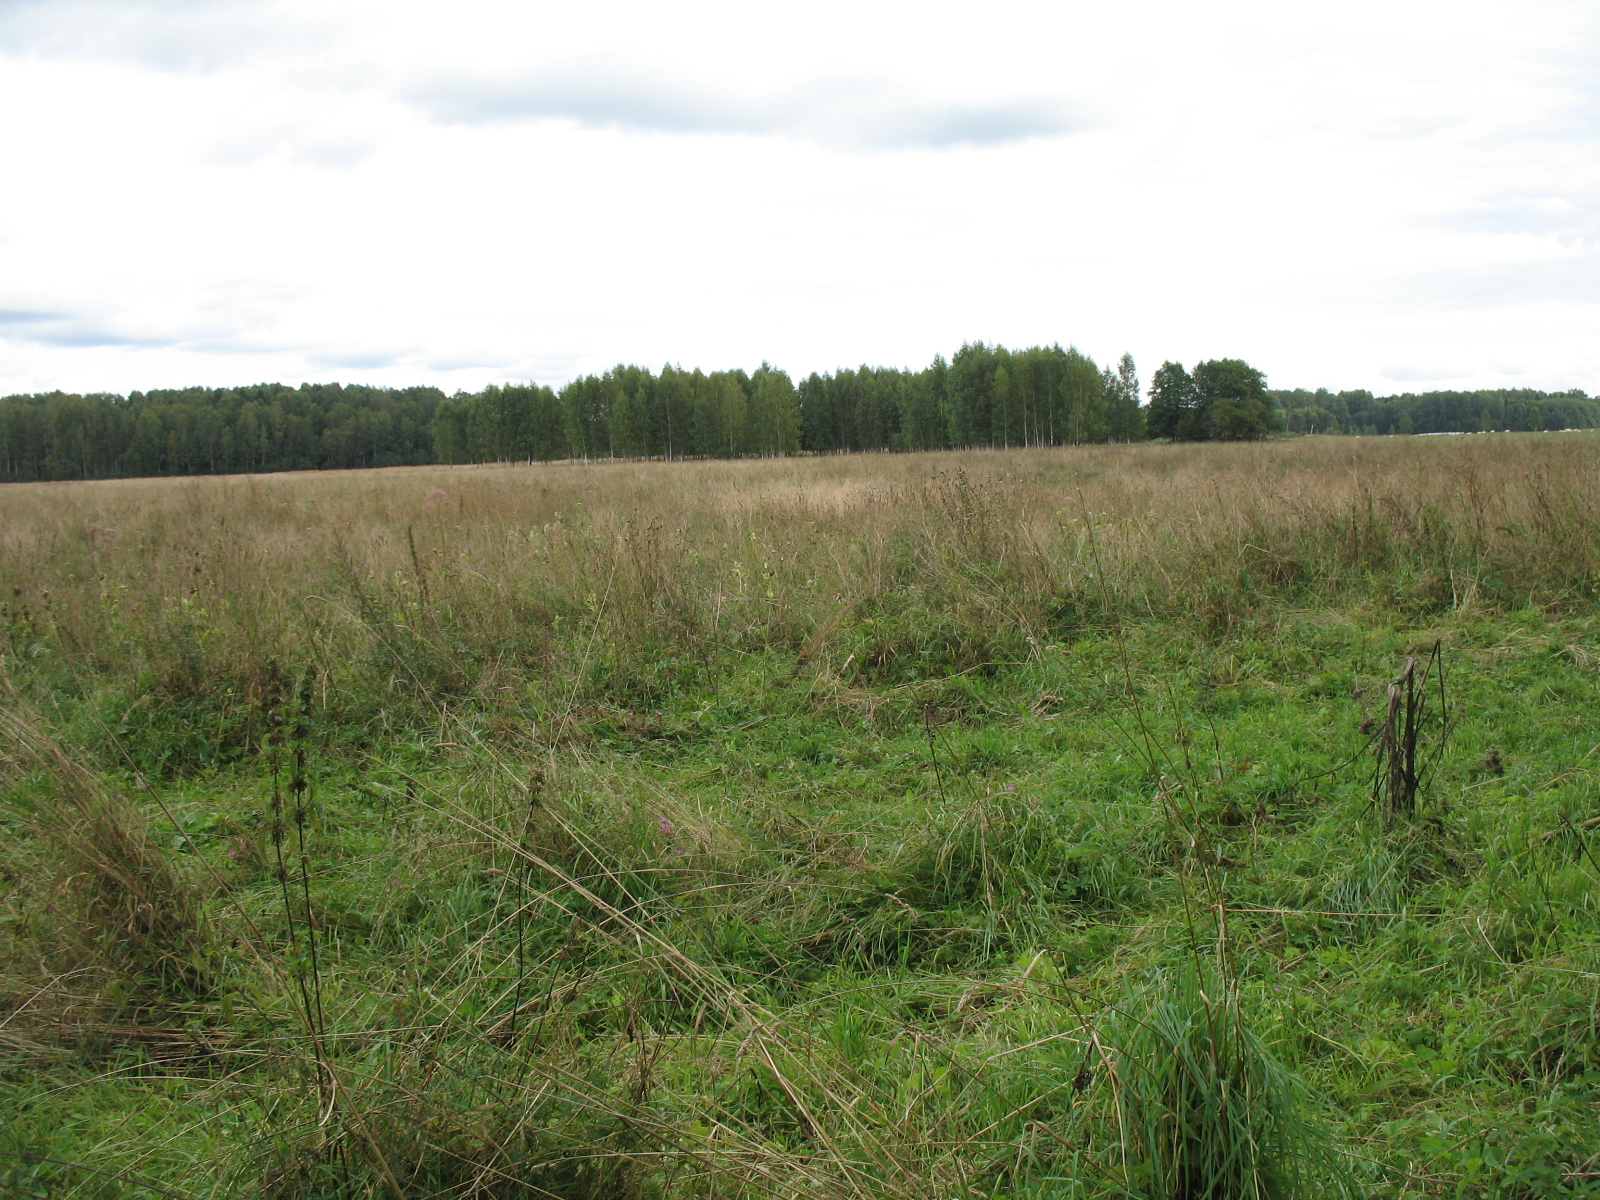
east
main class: Grassland
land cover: Grassland without tree/shrub cover
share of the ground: > 75 %
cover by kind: herbaceous plants 100 %
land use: Agriculture (excluding fallow land and kitchen gardens)
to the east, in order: Grassland without tree/shrub cover
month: September
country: LV
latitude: 56.1182
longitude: 25.9443
